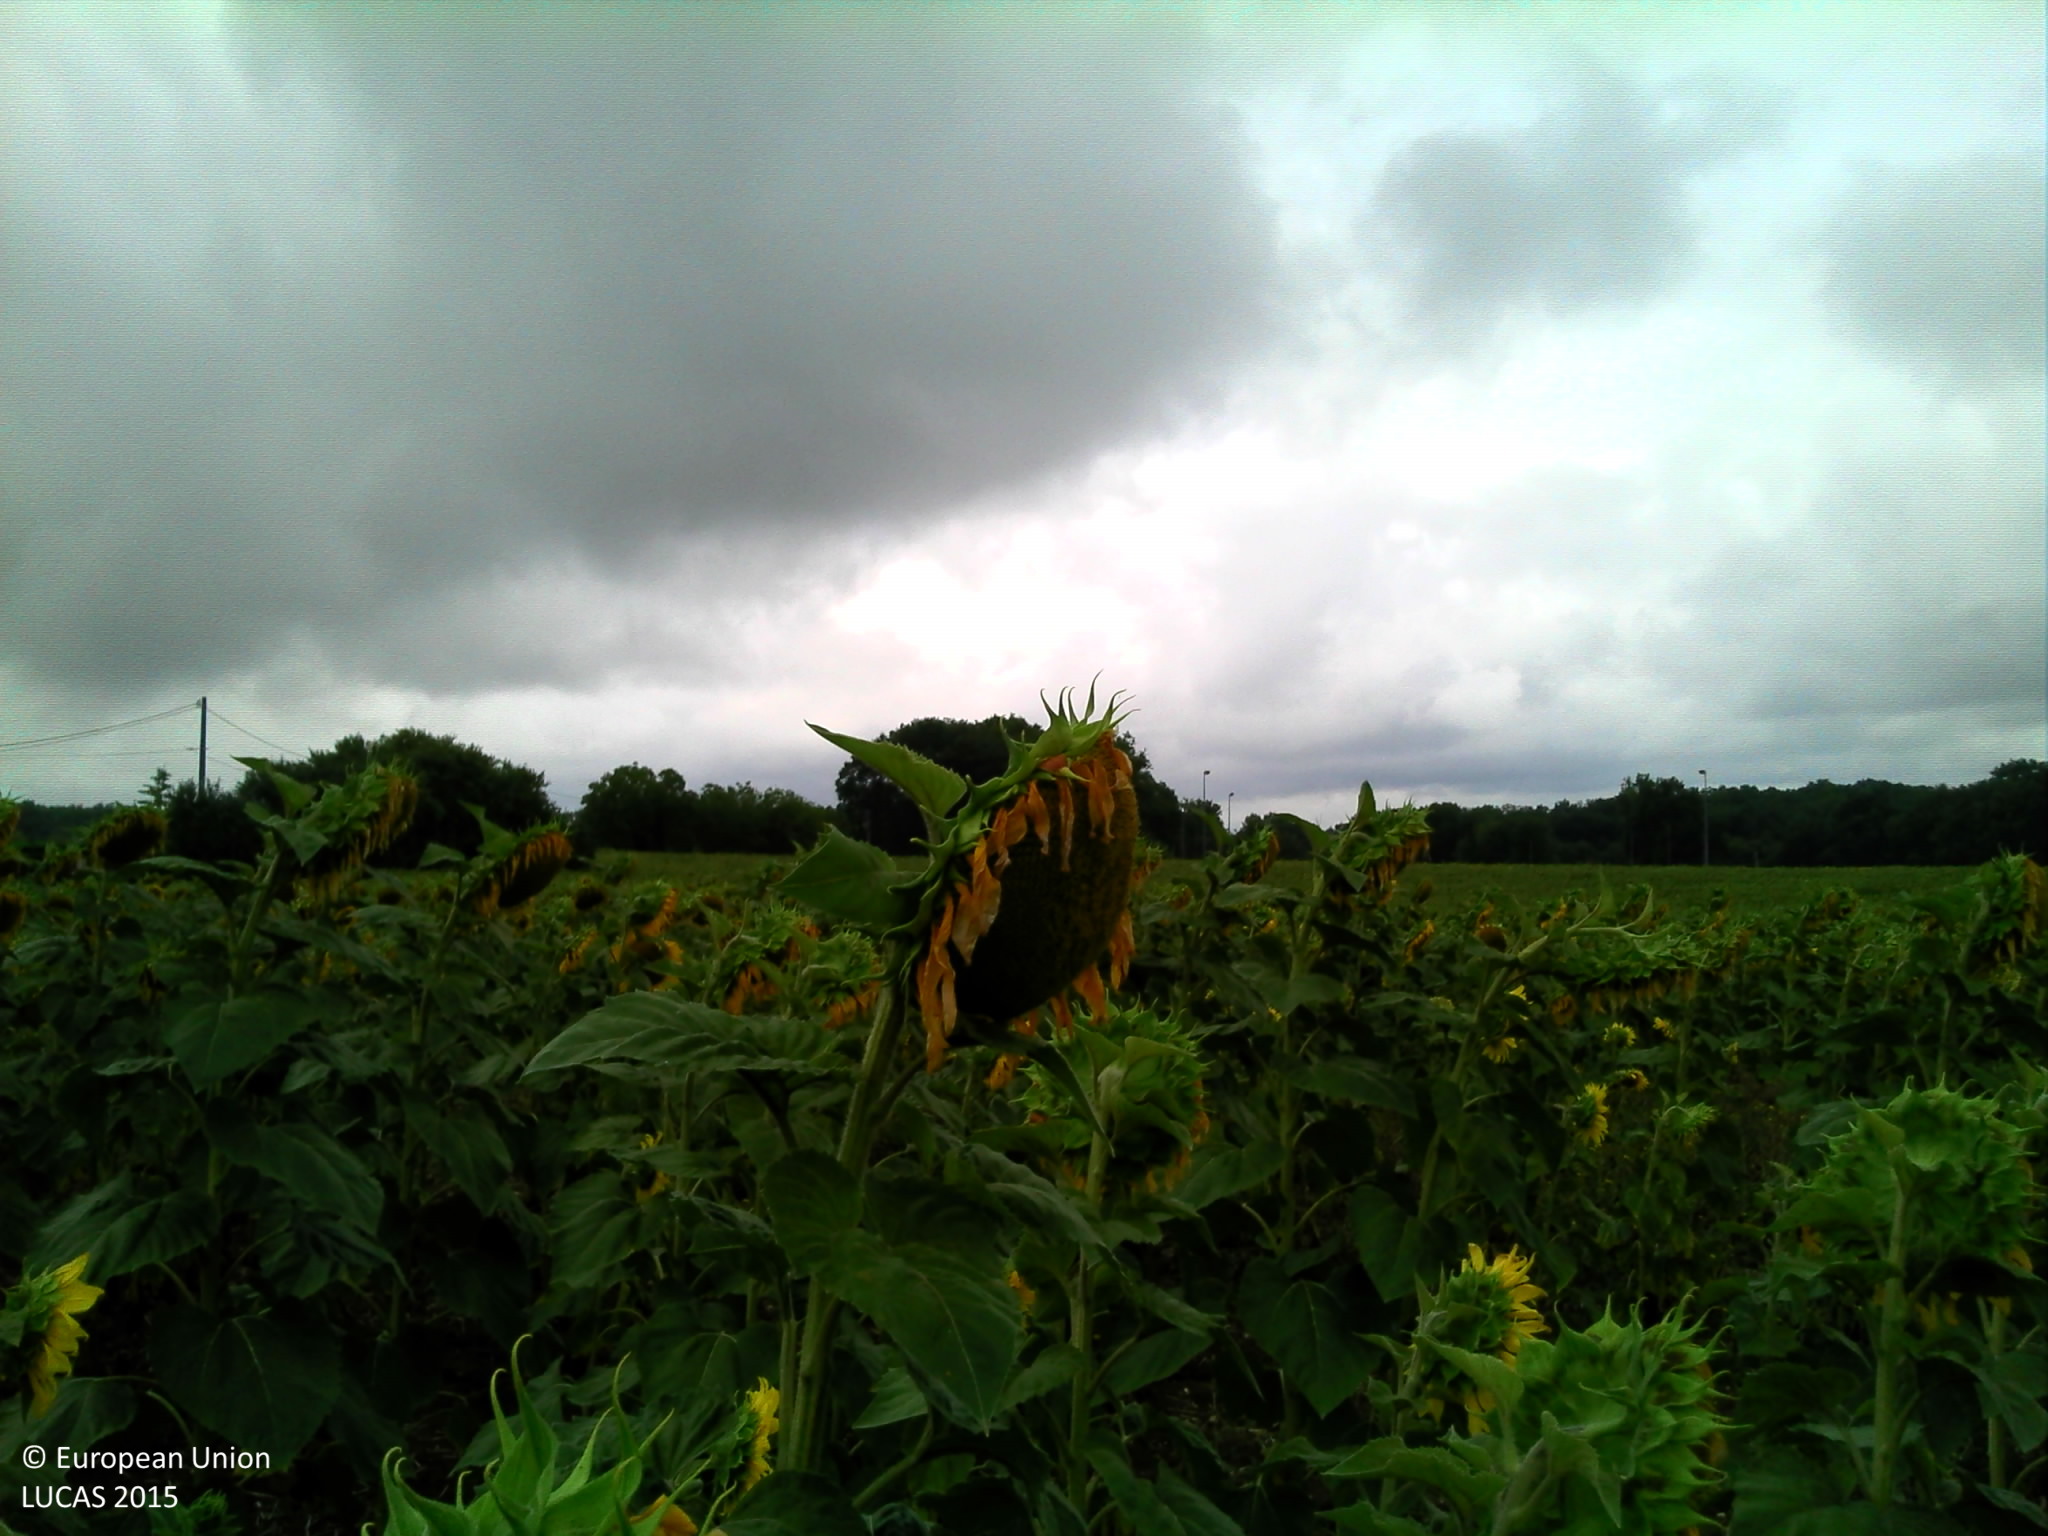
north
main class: Cropland
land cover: Sunflower
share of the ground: 50 - 75 %
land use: Agriculture (excluding fallow land and kitchen gardens)
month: August
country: FR
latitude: 44.6911
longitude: 0.8706
